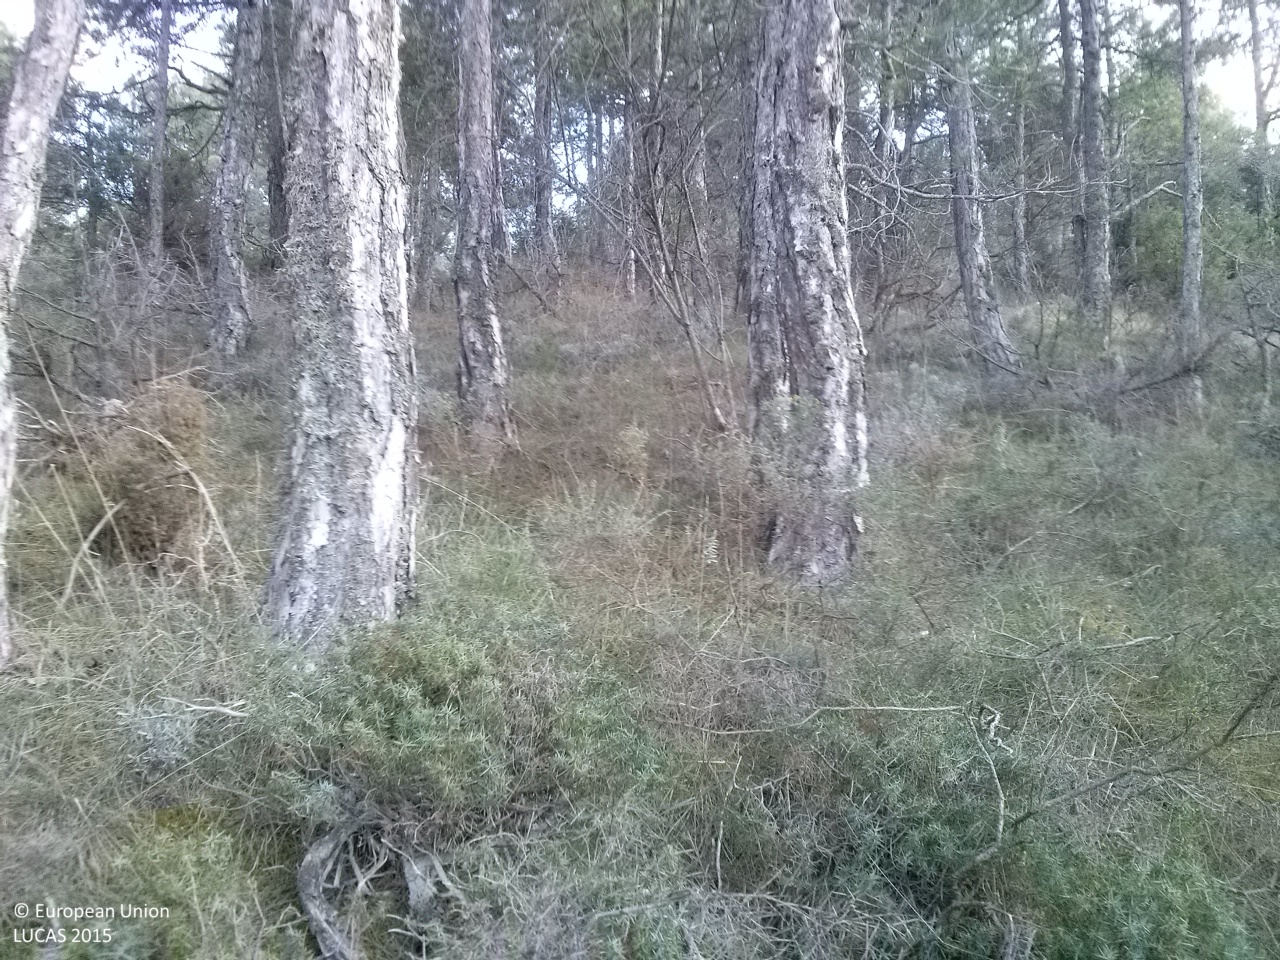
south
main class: Woodland
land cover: Pine dominated coniferous woodland
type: coniferous forest of the mediterranean region
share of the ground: 50 - 75 %
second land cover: Grassland without tree/shrub cover
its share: 50 - 75 %
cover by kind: coniferous forest trees 50 %, herbaceous plants 30 %, unconsolidated bare surface 15 %, shrubs 5 %
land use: Forestry
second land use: Agriculture (excluding fallow land and kitchen gardens)
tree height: > 5 m
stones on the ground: 10 - 25 %
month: April
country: ES
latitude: 40.1114
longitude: -1.7098
